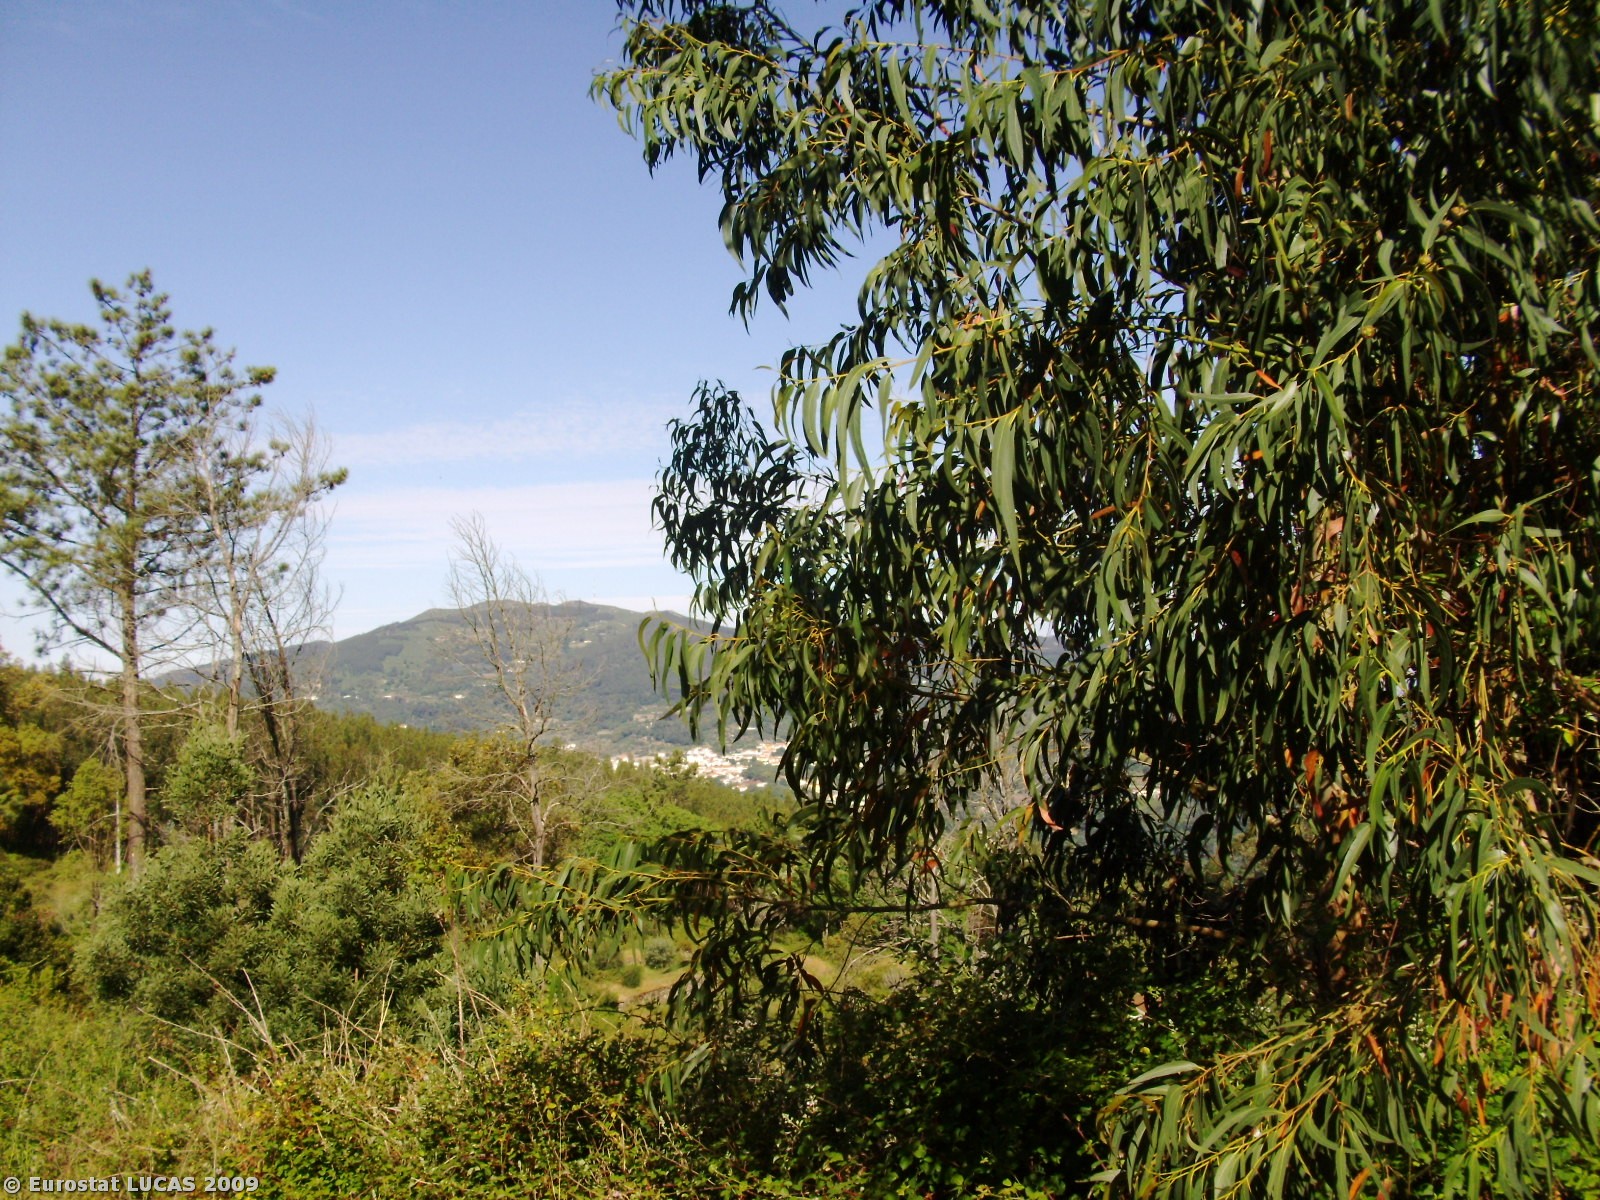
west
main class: Shrubland
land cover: Shrubland with sparse tree cover
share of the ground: > 75 %
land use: Nature reserves
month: June
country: PT
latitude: 37.3191
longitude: -8.5242
